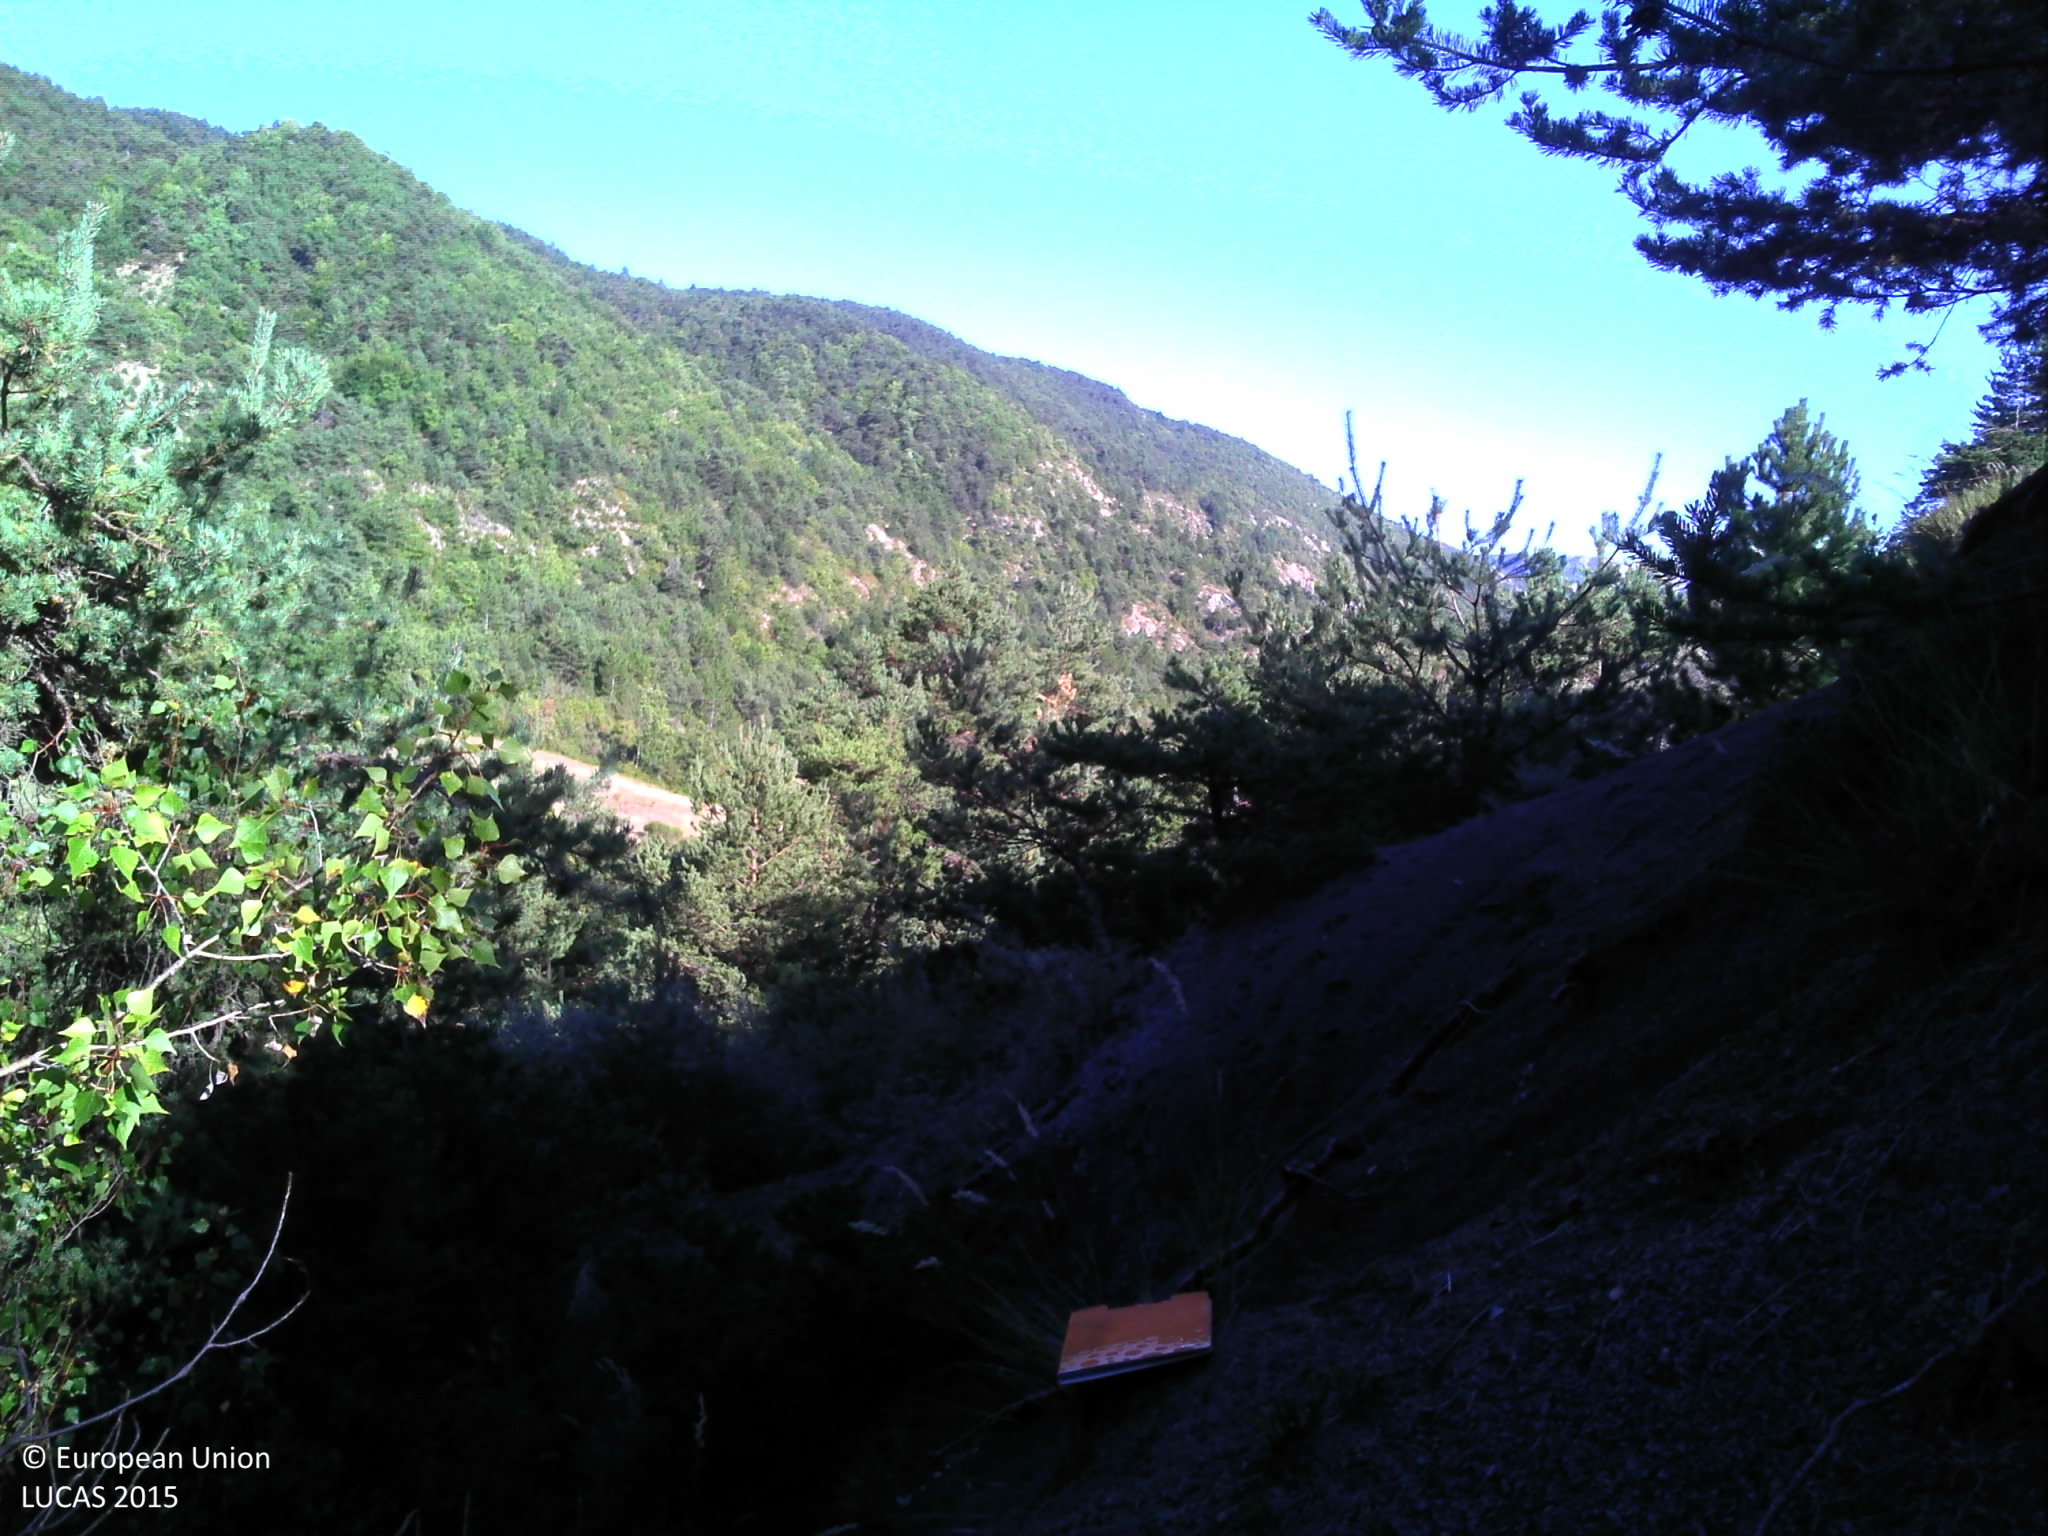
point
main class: Shrubland
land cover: Shrubland with sparse tree cover
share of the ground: > 75 %
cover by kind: shrubs 65 %, unconsolidated bare surface 20 %, consolidated bare surface 10 %, coniferous forest trees 5 %
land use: Semi-natural and natural areas not in use
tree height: < 5 m
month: September
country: FR
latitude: 44.4977
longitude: 5.3160
